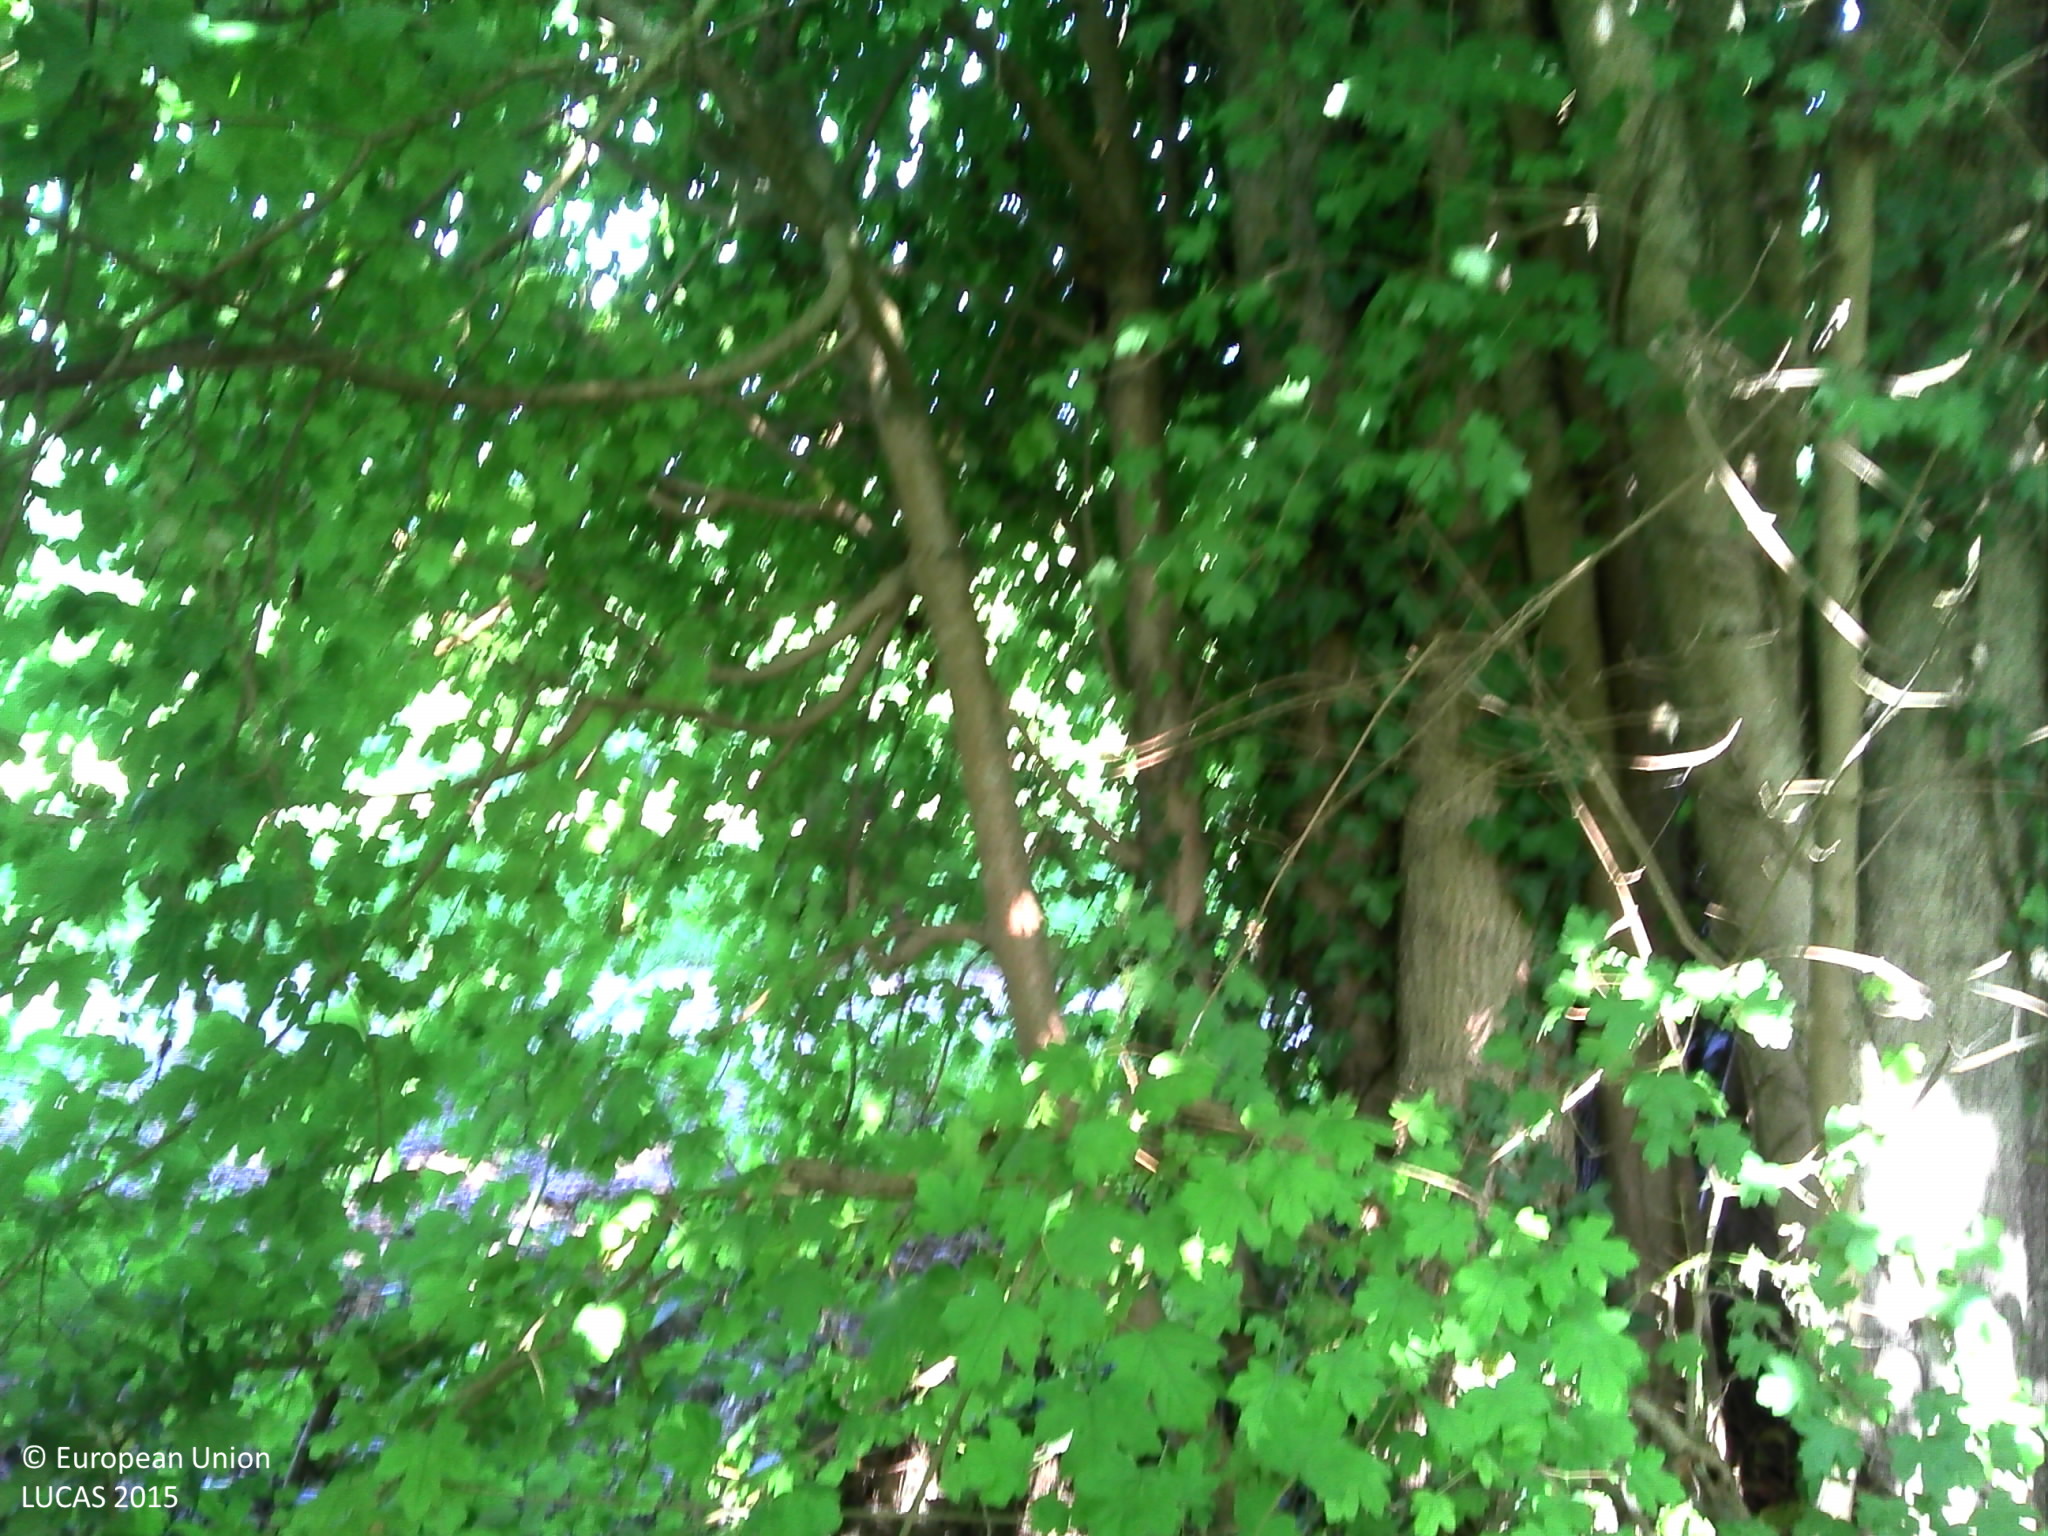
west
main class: Woodland
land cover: Broadleaved woodland
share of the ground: > 75 %
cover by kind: broadleaved forest trees 85 %, unconsolidated bare surface 10 %, herbaceous plants 5 %
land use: Semi-natural and natural areas not in use
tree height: > 5 m
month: July
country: FR
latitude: 43.0004
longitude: 1.0371
